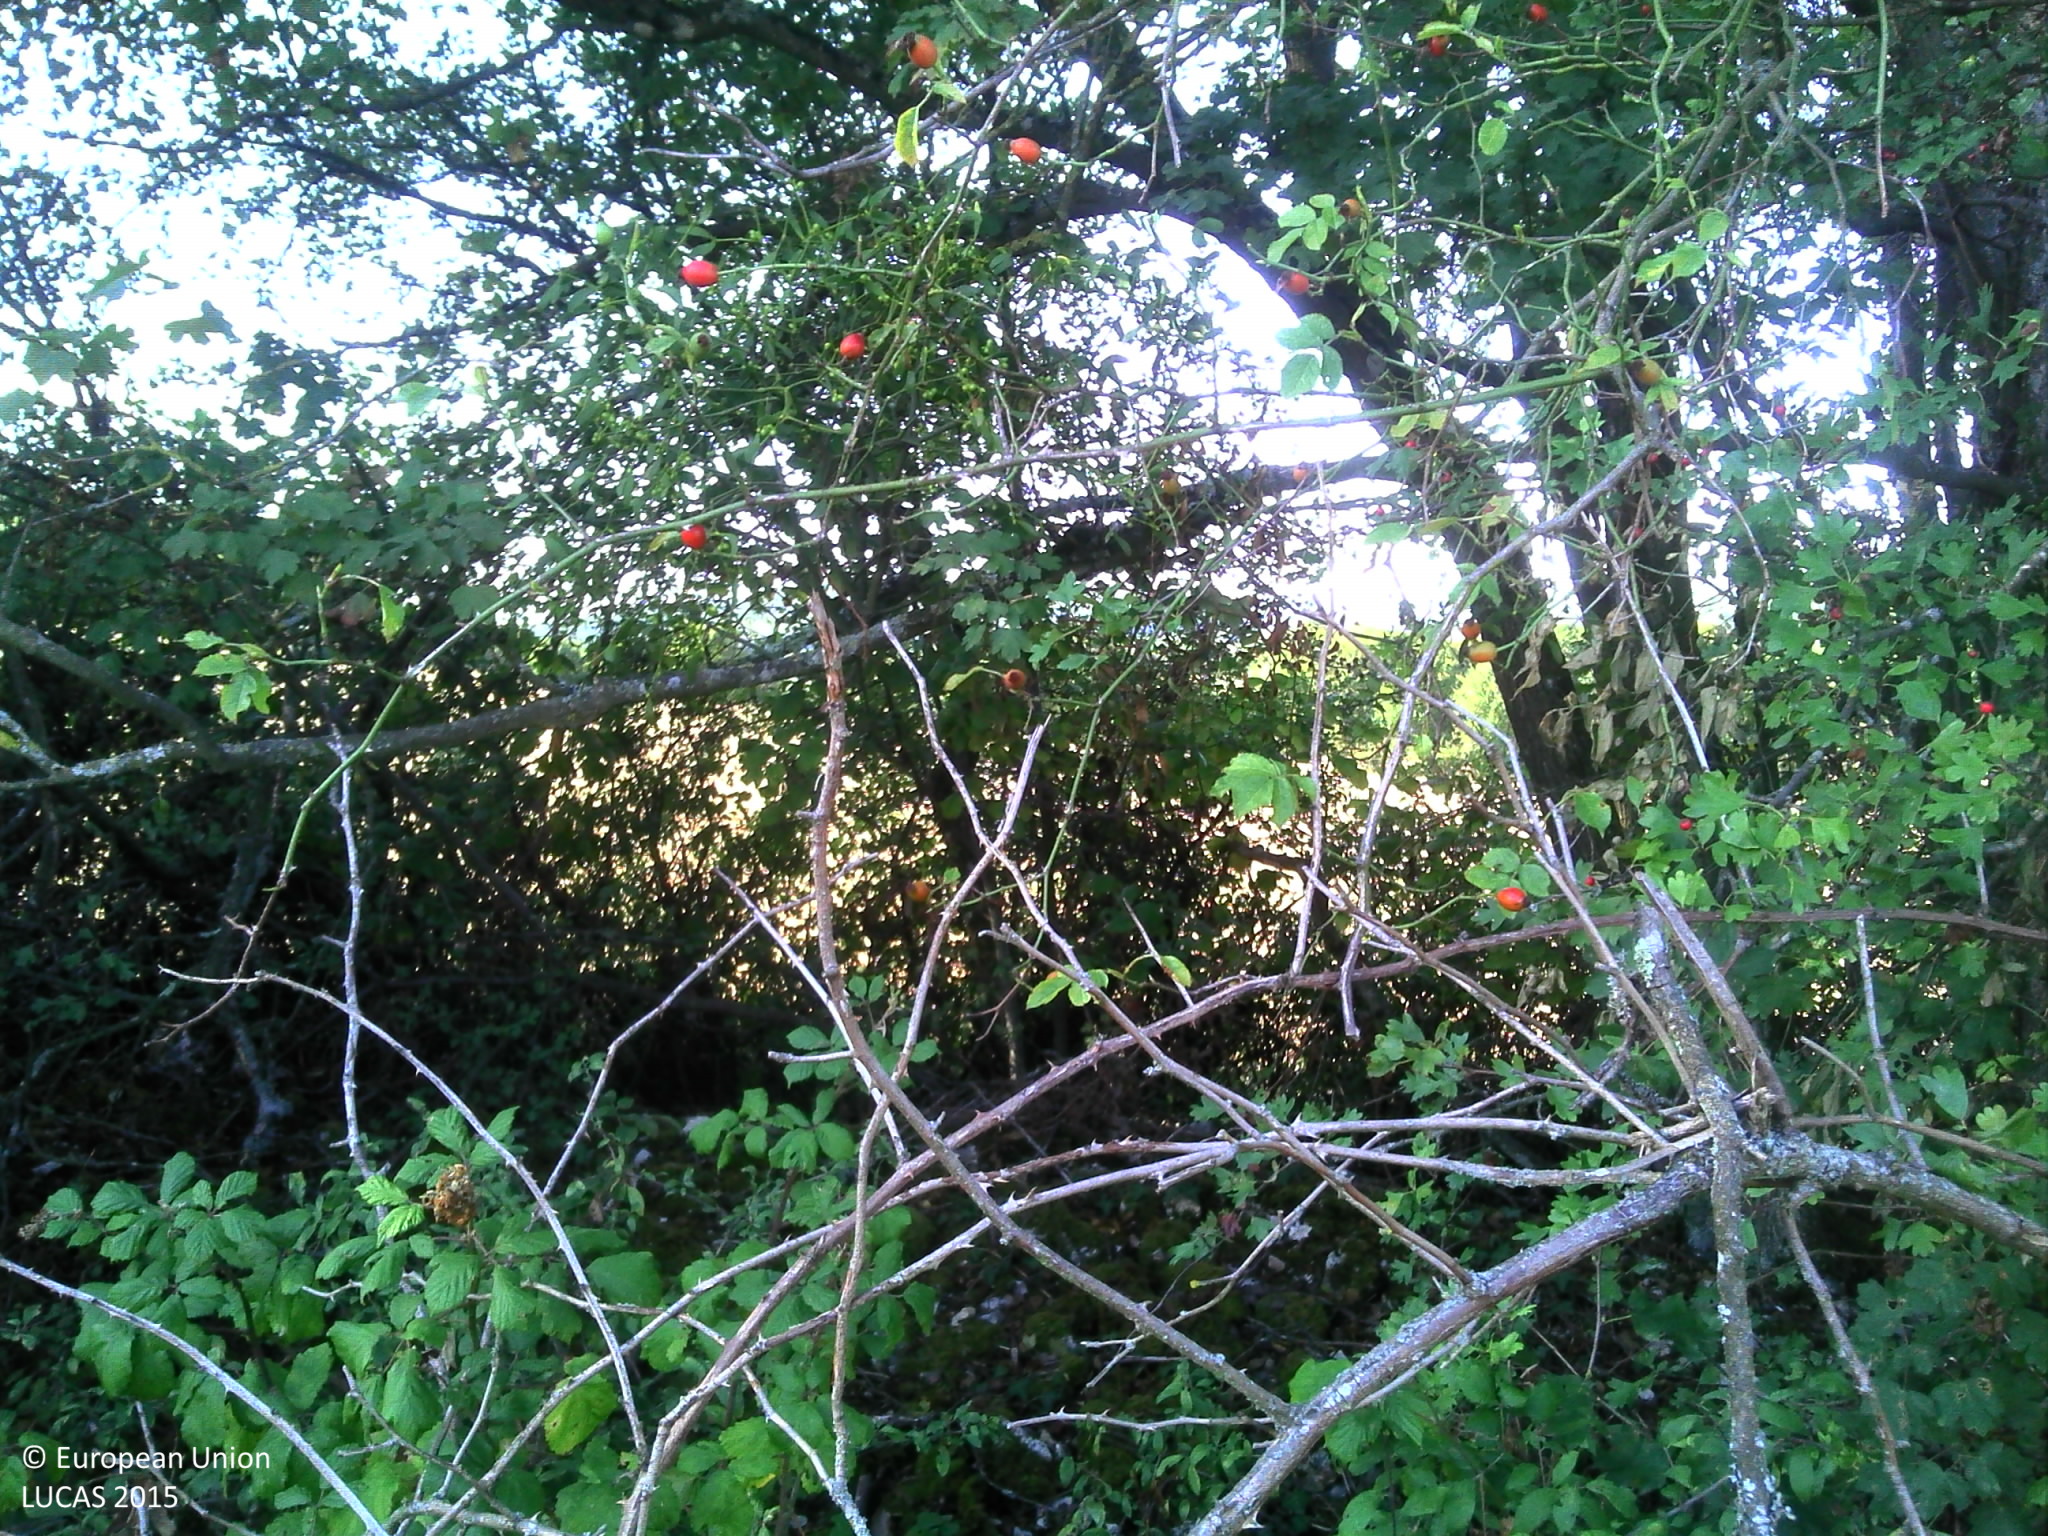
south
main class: Woodland
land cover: Broadleaved woodland
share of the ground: > 75 %
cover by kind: broadleaved forest trees 100 %
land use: Agriculture (excluding fallow land and kitchen gardens)
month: August
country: FR
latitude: 46.4584
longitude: 4.7807
